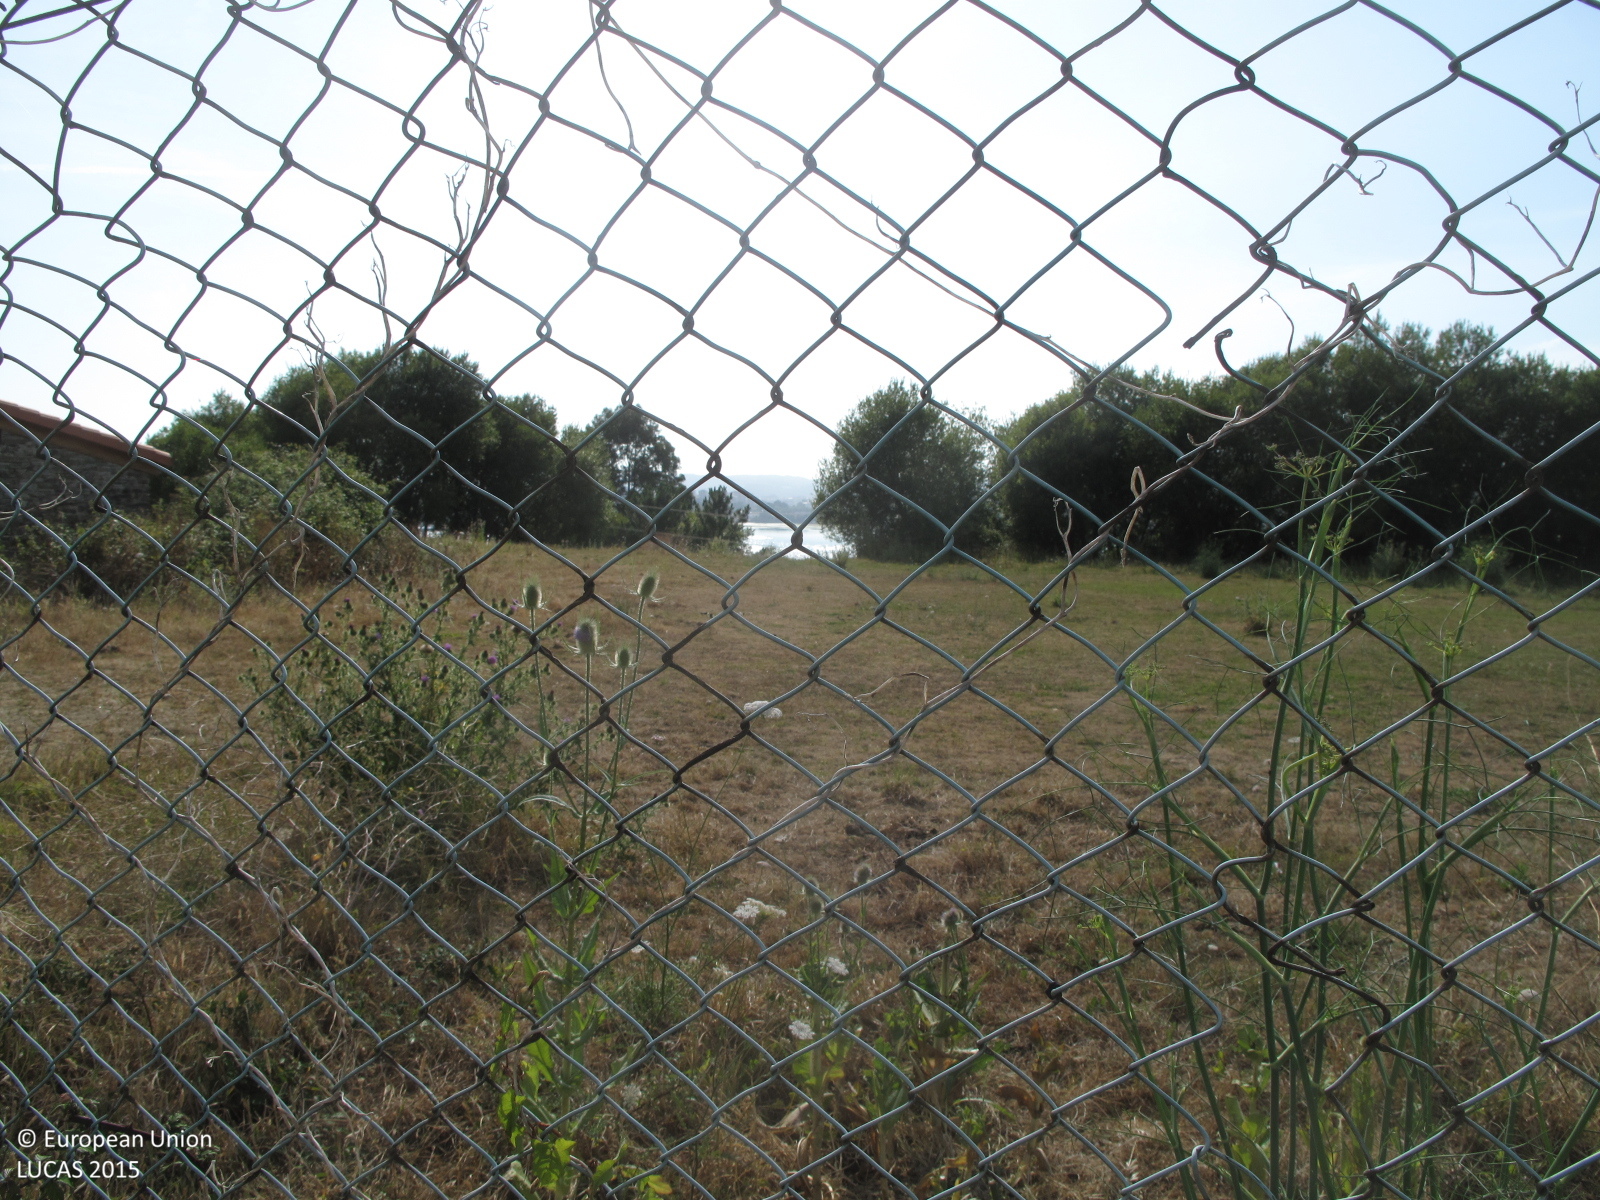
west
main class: Woodland
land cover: Broadleaved woodland
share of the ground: > 75 %
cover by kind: broadleaved forest trees 90 %, herbaceous plants 10 %
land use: Residential
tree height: > 5 m
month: July
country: ES
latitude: 43.4871
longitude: -8.1660
